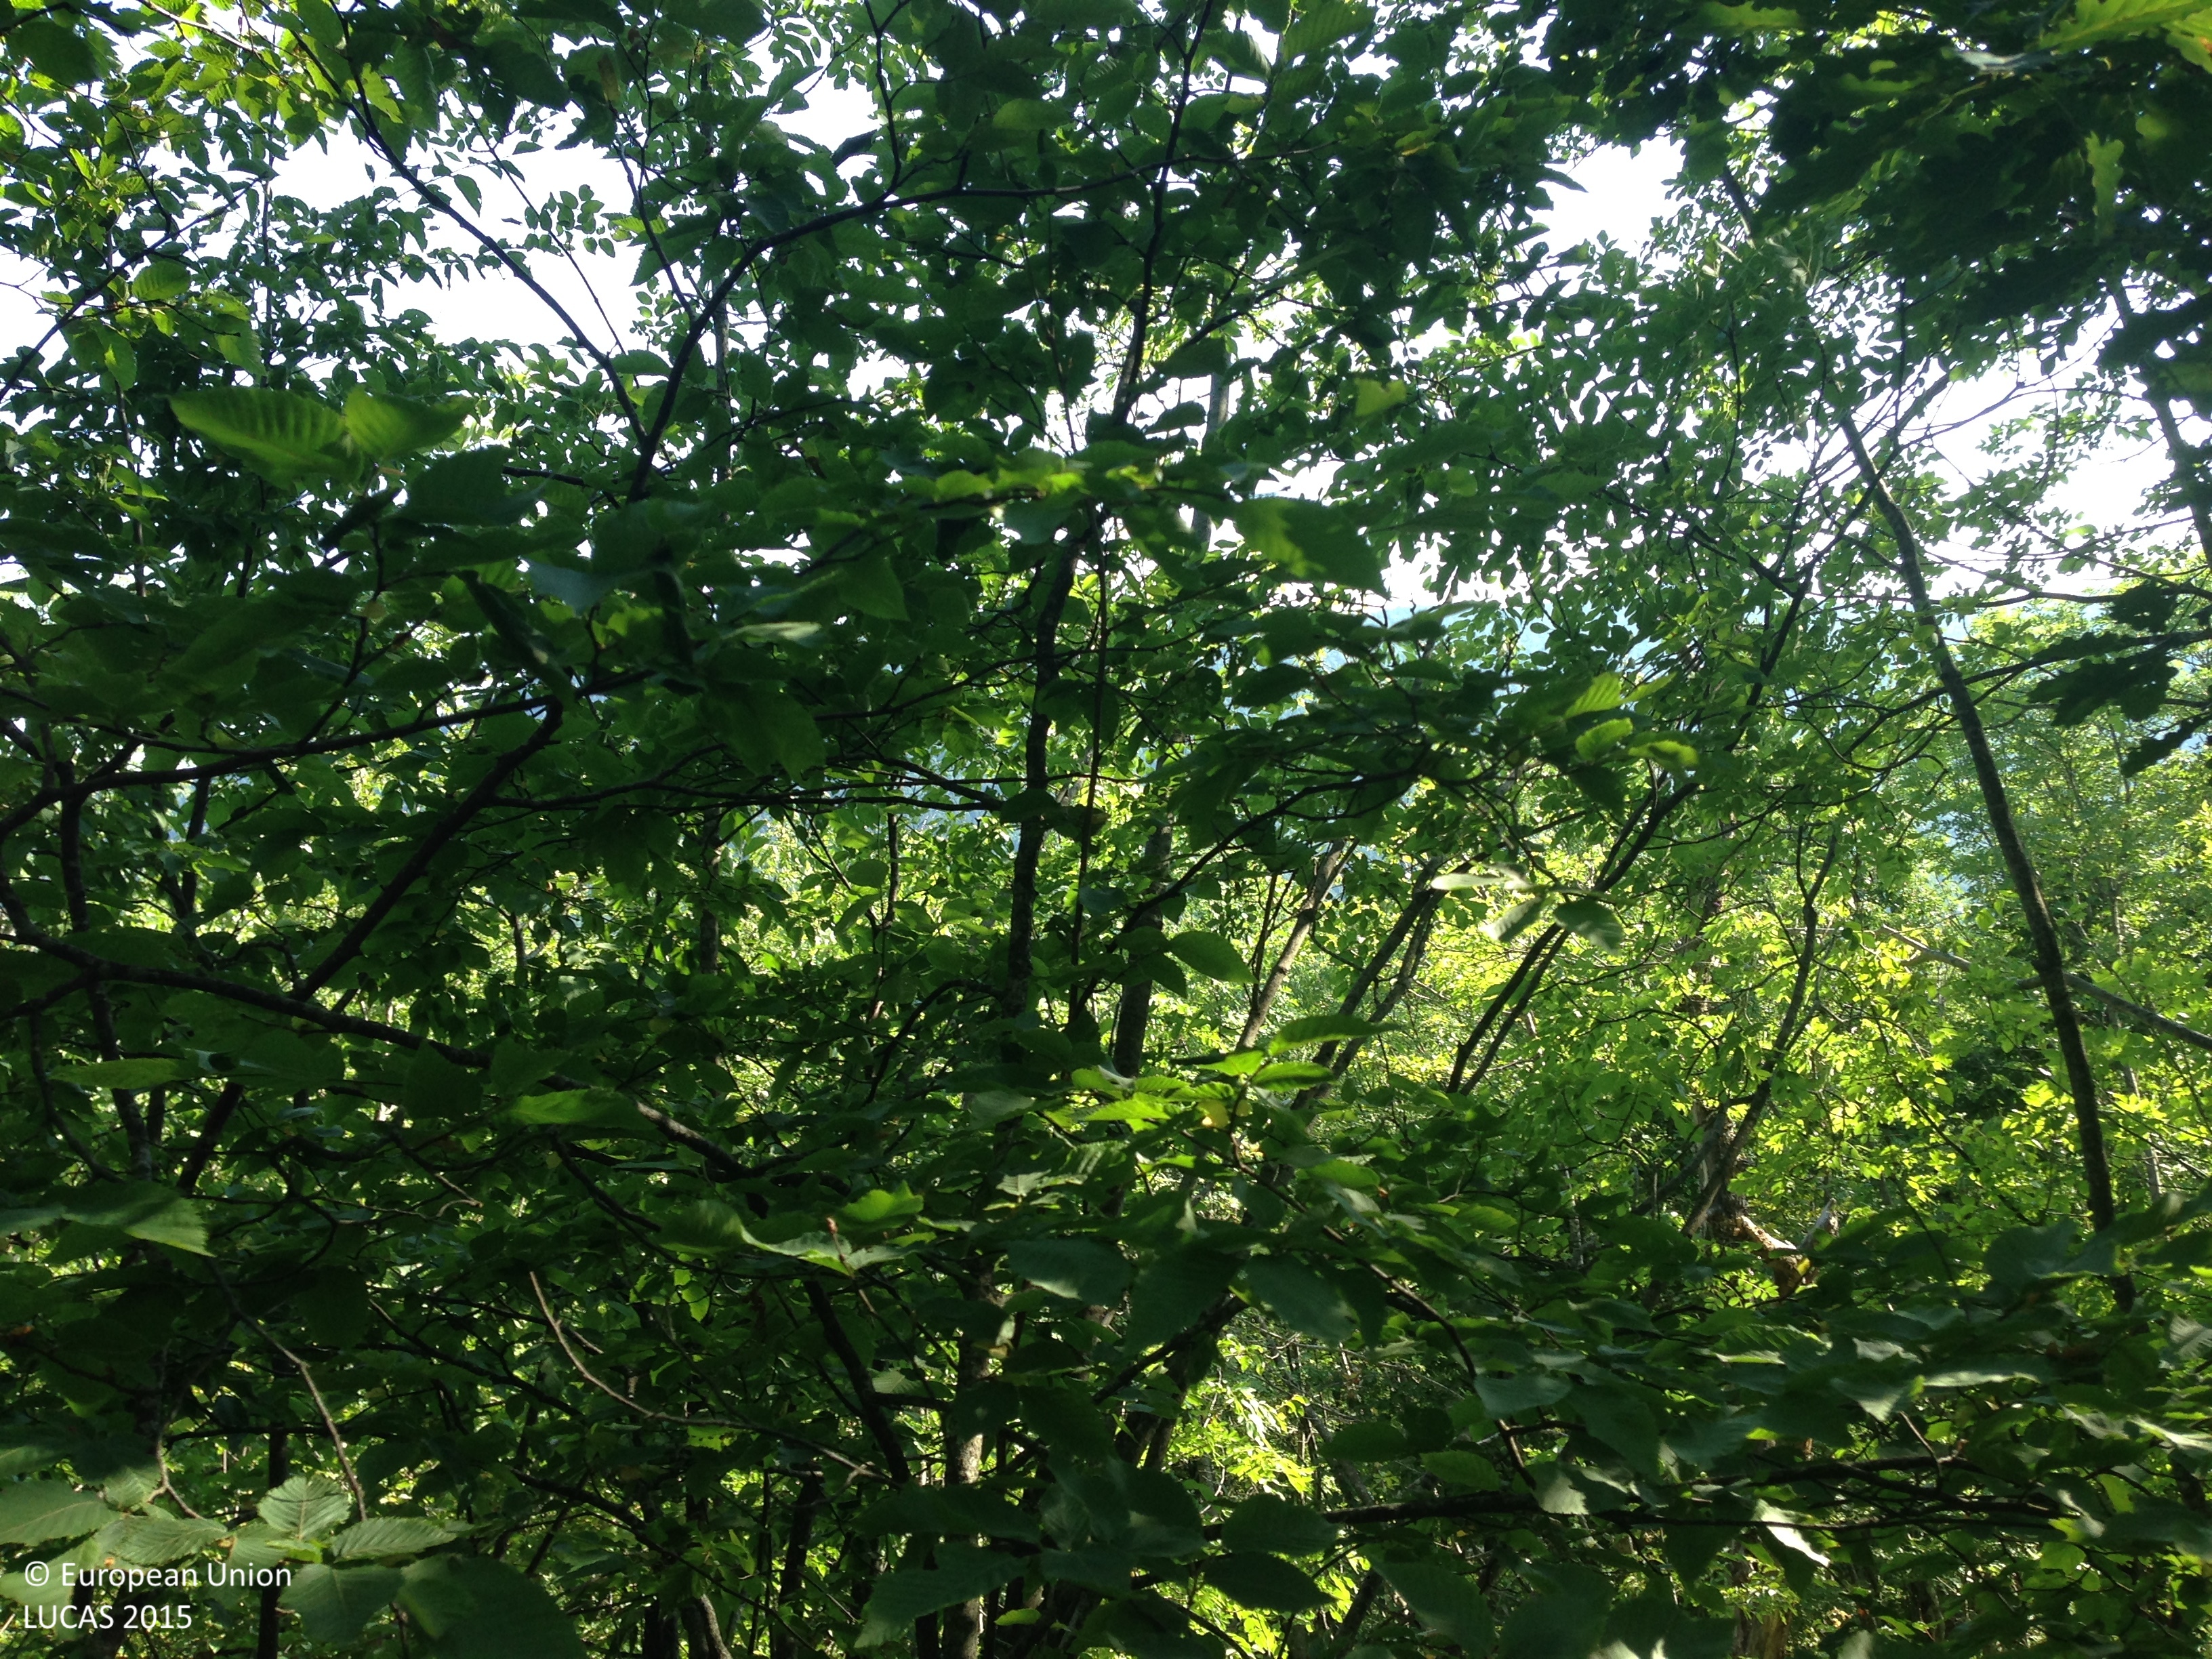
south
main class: Woodland
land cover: Broadleaved woodland
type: thermophilous deciduous forest
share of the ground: > 75 %
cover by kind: broadleaved forest trees 55 %, herbaceous plants 20 %, lichens and mosses 10 %, consolidated bare surface 10 %, unconsolidated bare surface 5 %
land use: Forestry
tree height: > 5 m
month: July
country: HR
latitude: 44.7821
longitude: 15.1629
